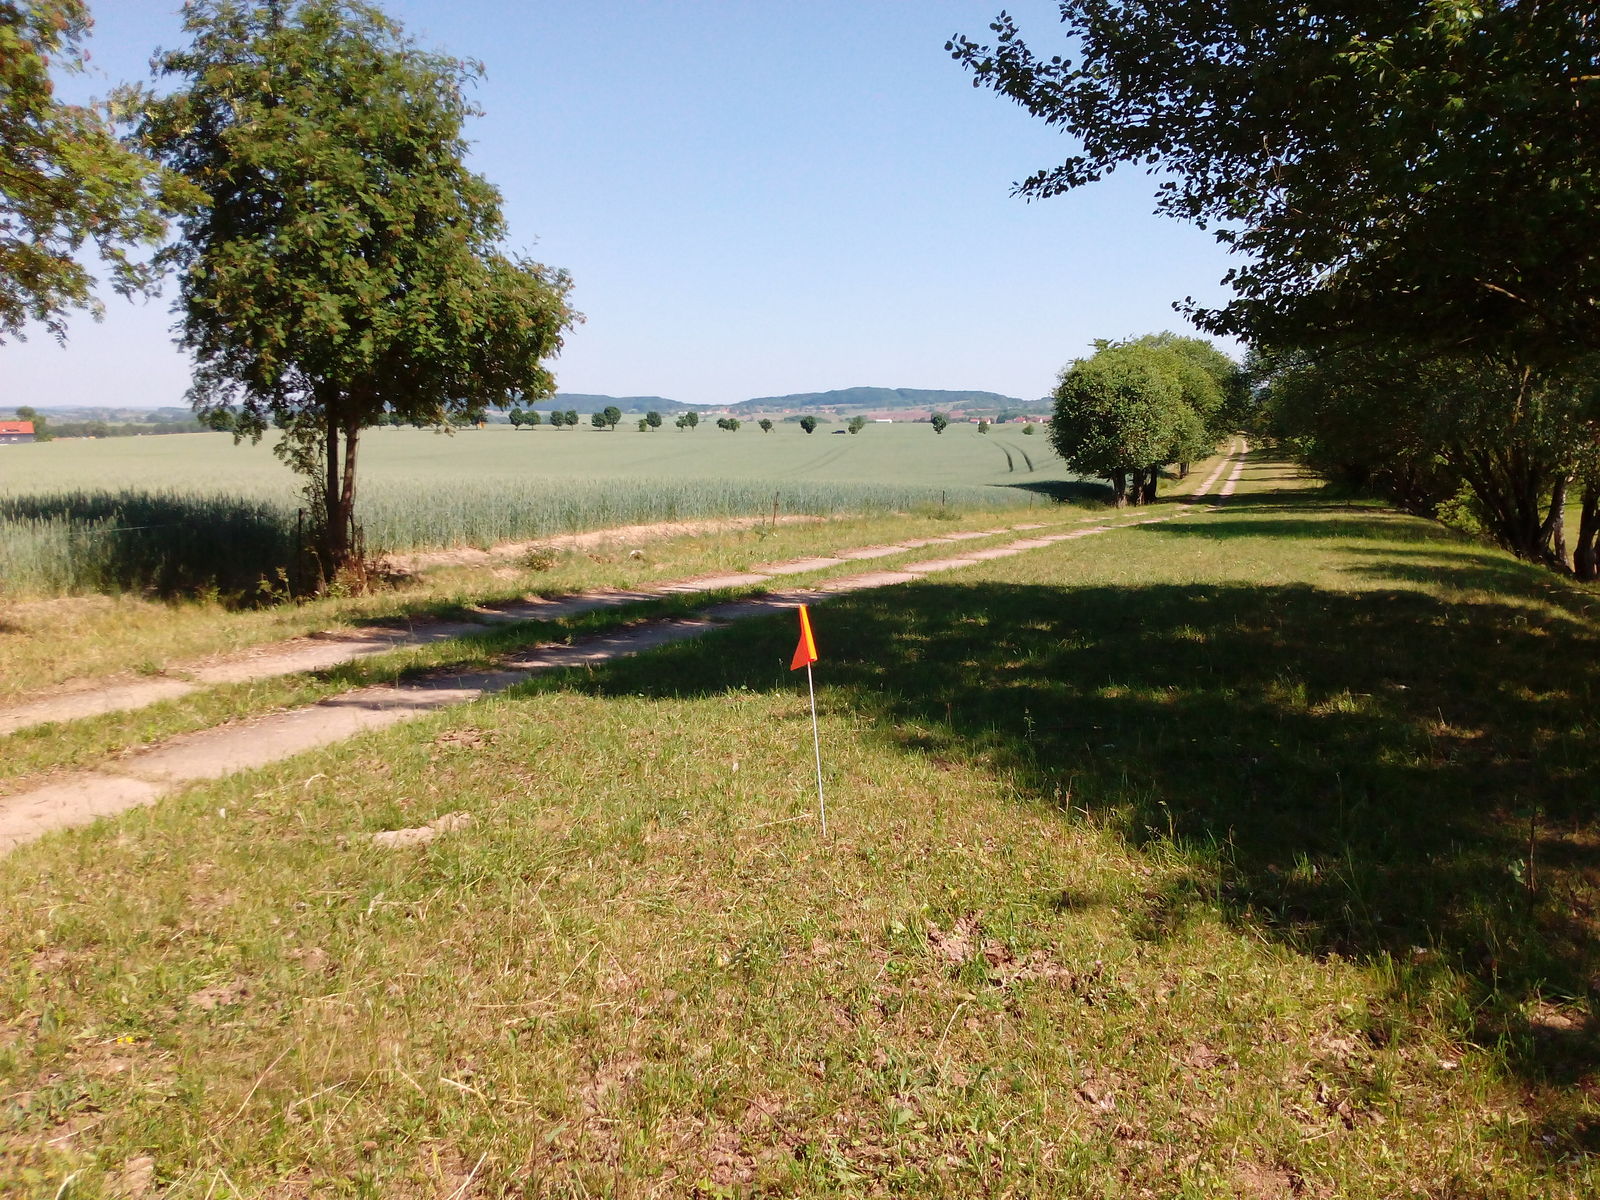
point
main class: Grassland
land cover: Grassland without tree/shrub cover
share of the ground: > 75 %
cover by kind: herbaceous plants 100 %
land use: Agriculture (excluding fallow land and kitchen gardens)
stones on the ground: < 10 %
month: June
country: DE
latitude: 50.3627
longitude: 10.5481
